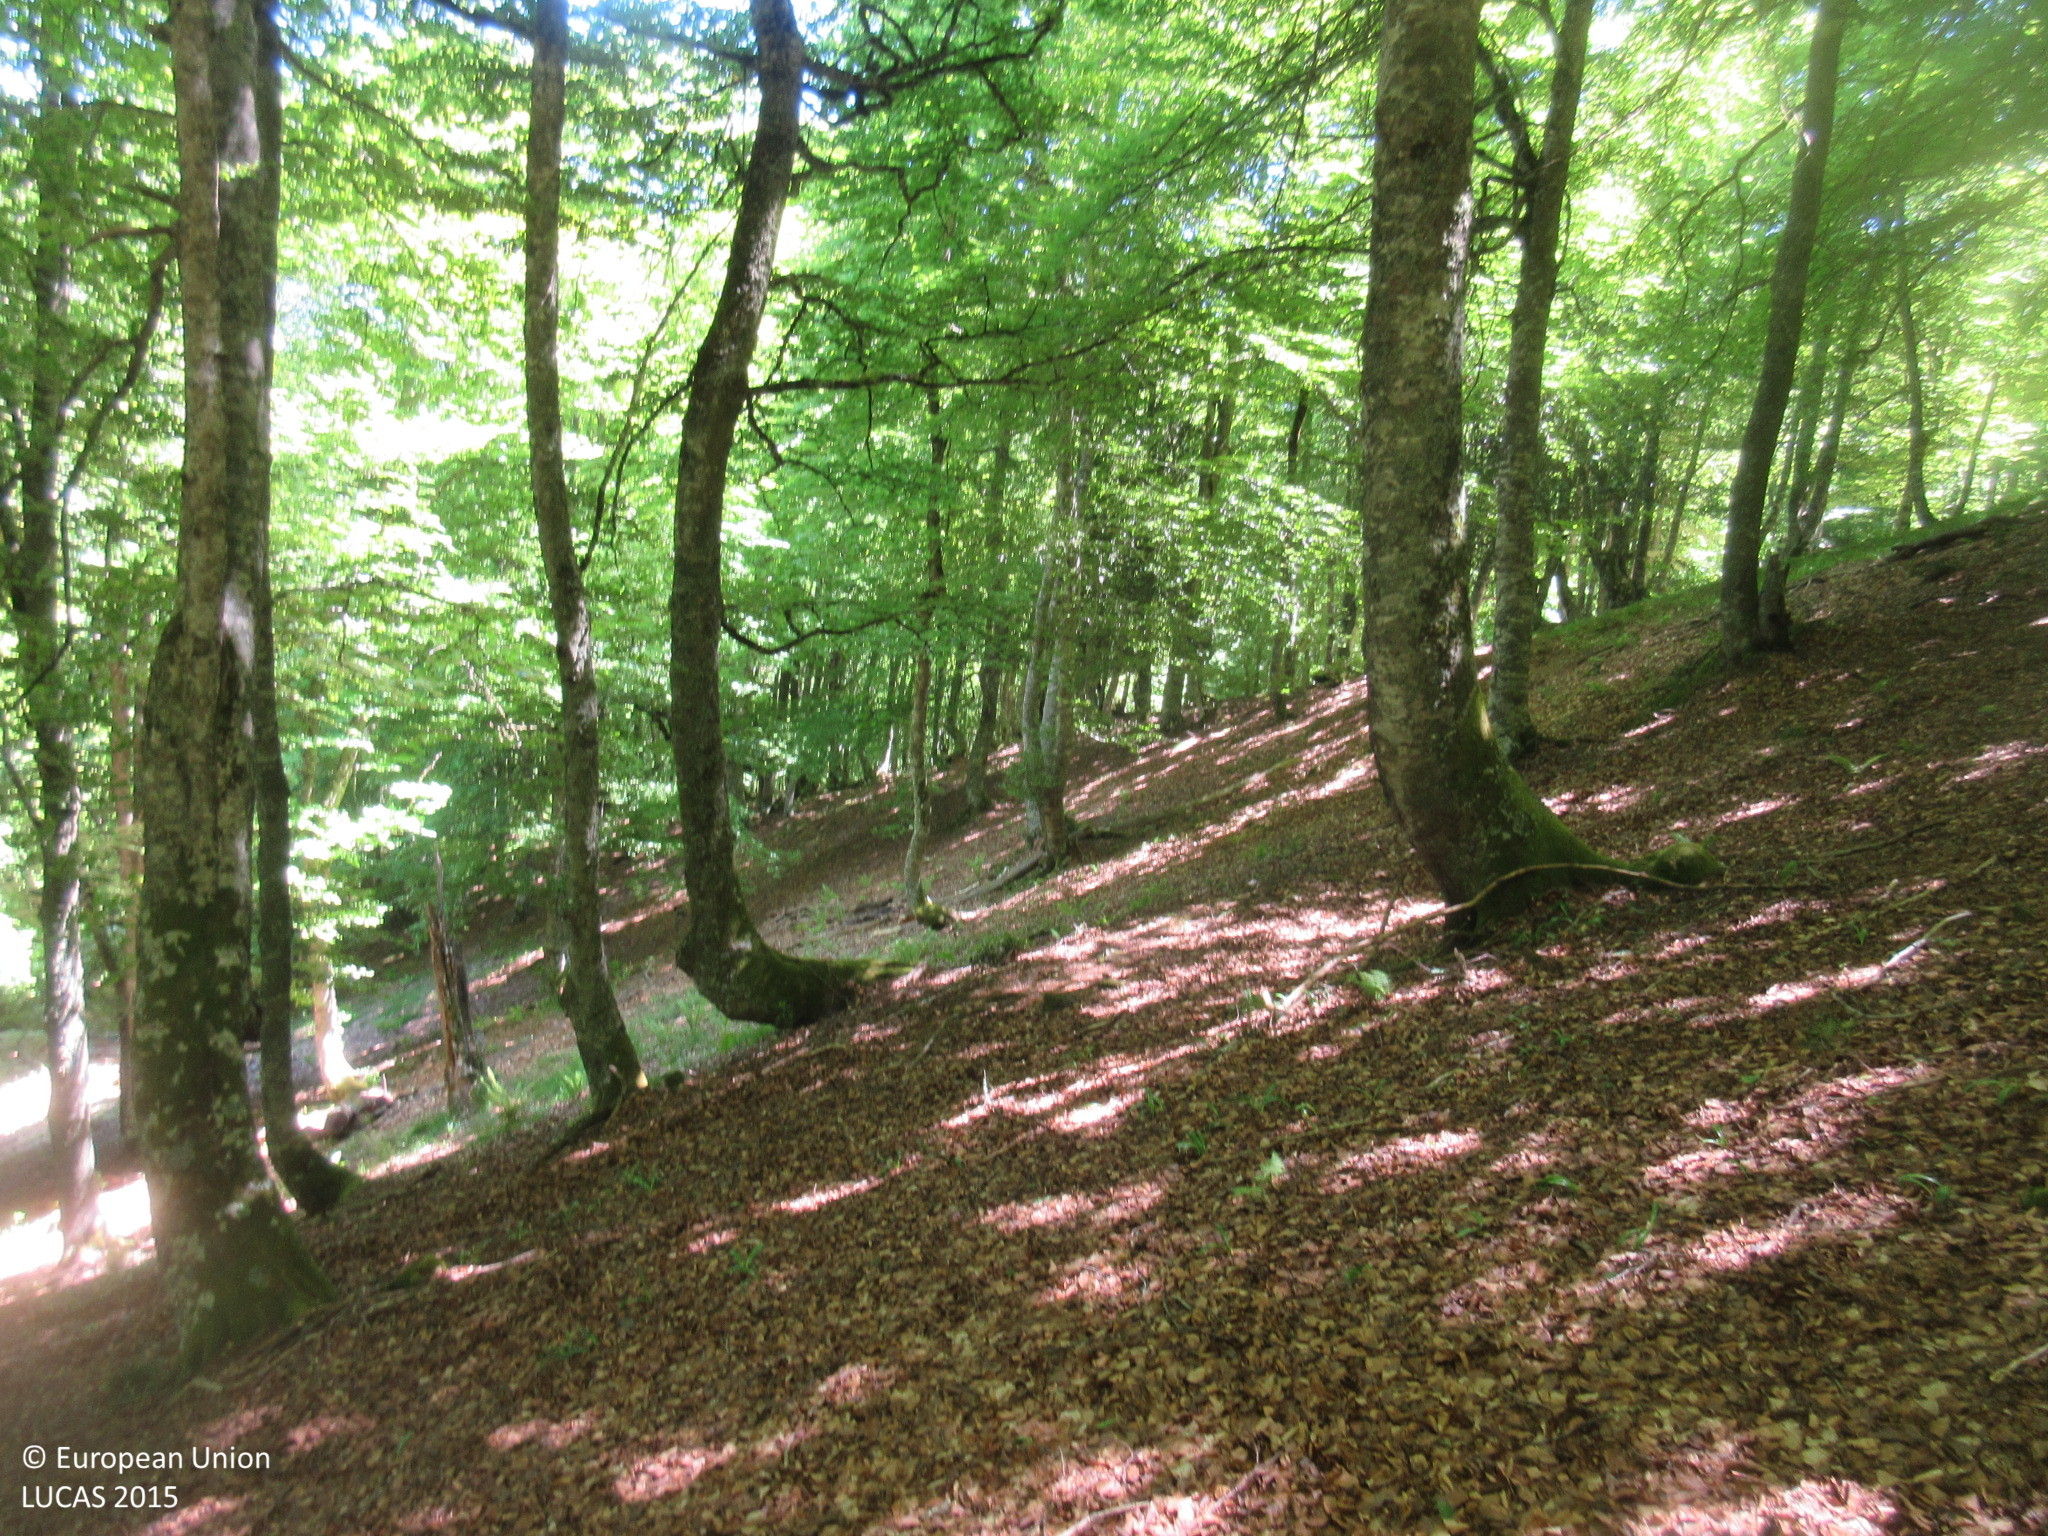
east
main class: Woodland
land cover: Broadleaved woodland
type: beech forest
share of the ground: > 75 %
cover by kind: broadleaved forest trees 95 %, unconsolidated bare surface 5 %
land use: Semi-natural and natural areas not in use
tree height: > 5 m
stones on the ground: 10 - 25 %
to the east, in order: Broadleaved woodland; Fences; Shrubland with sparse tree cover; Fences; Shruby margins; Tracks; Broadleaved woodland
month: June
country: ES
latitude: 43.0782
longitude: -4.4388
